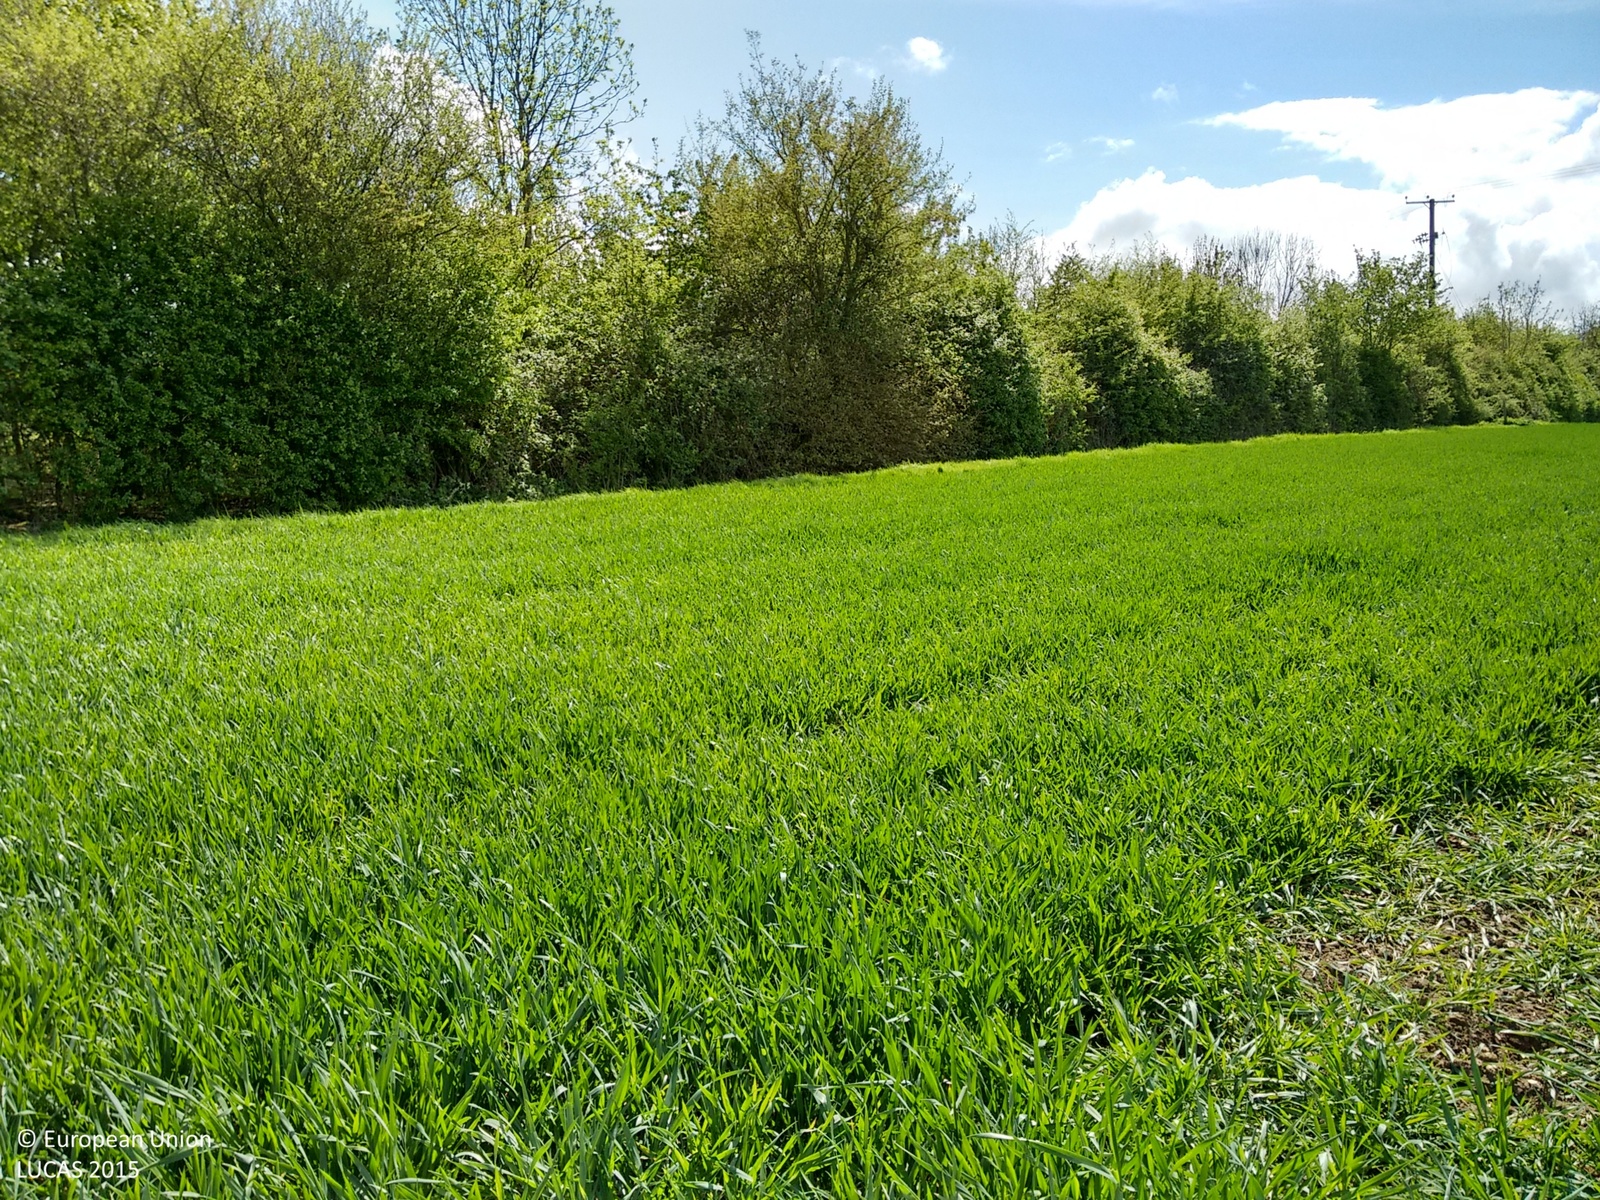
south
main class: Cropland
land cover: Common wheat
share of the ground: > 75 %
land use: Agriculture (excluding fallow land and kitchen gardens)
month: May
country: GB
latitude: 51.9897
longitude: -0.6267
